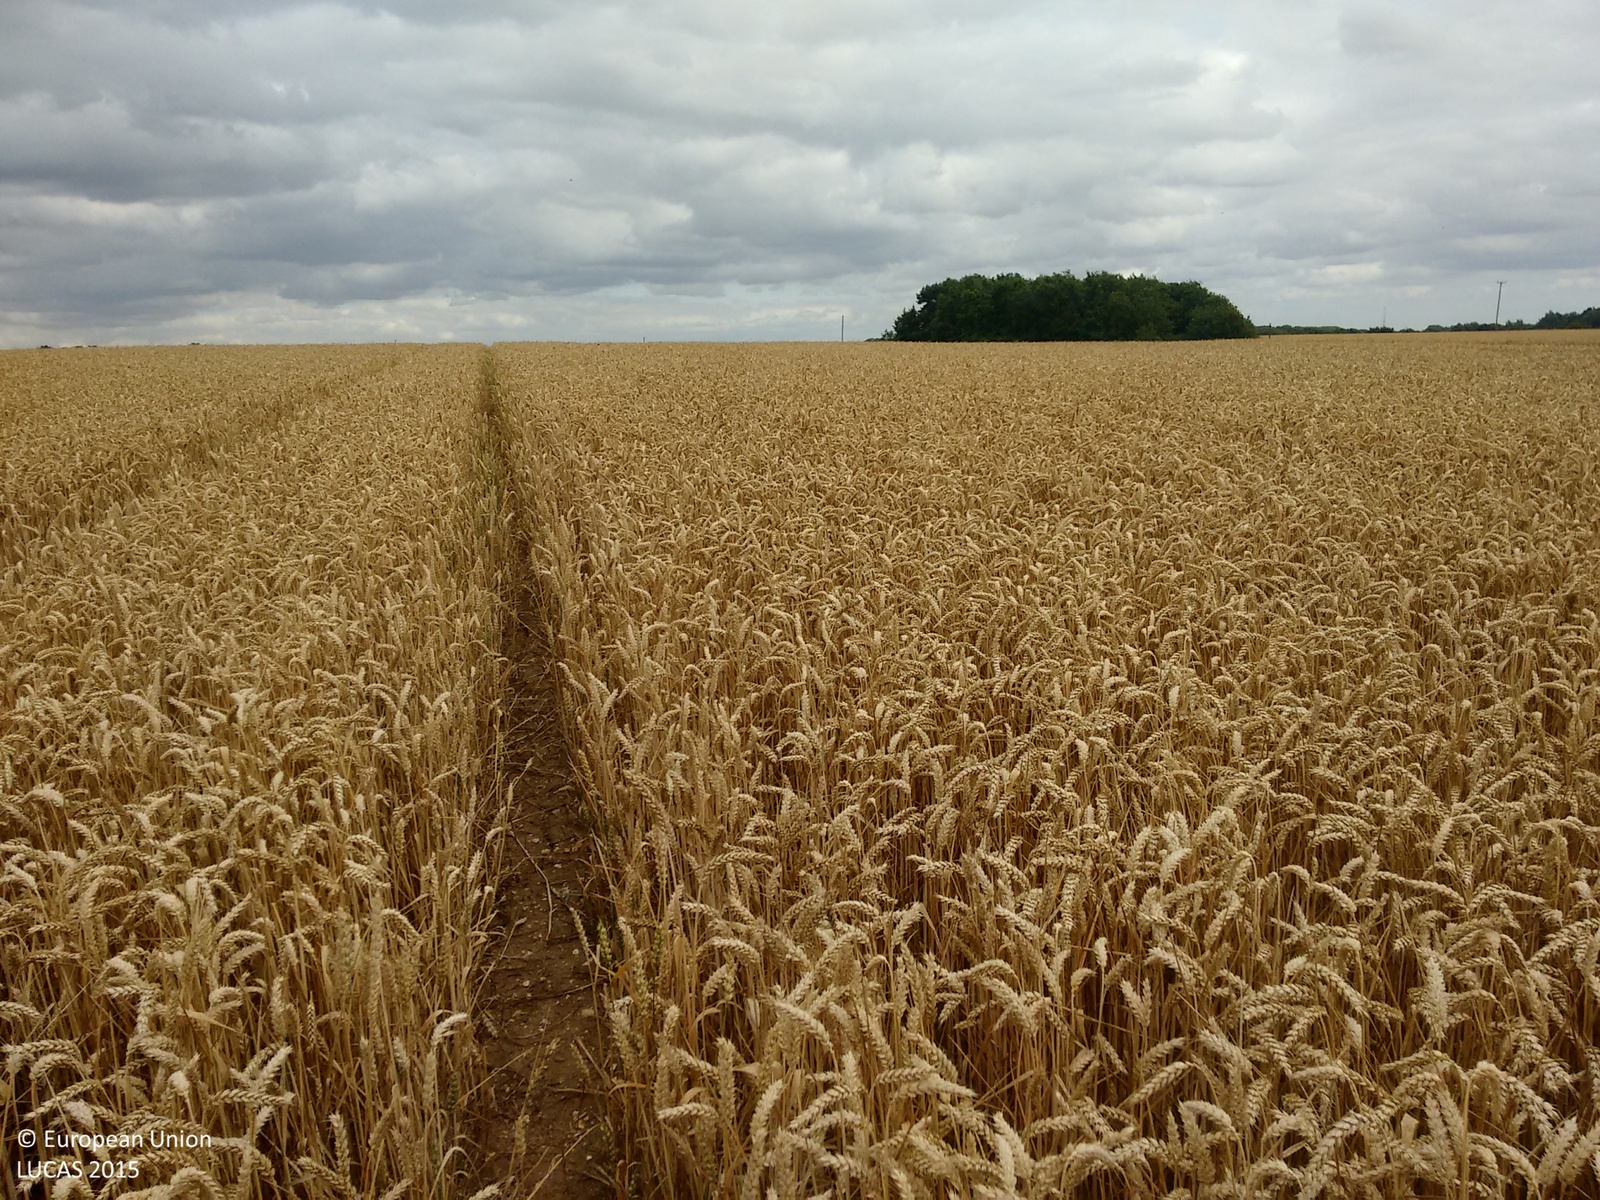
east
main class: Cropland
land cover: Common wheat
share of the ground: > 75 %
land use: Agriculture (excluding fallow land and kitchen gardens)
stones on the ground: 10 - 25 %
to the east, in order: Common wheat; Grassland without tree/shrub cover; Shrubland with sparse tree cover; Ditches and canals; Grass margins; Electric lines; Tracks; Grass margins; Managed hedges; Broadleaved woodland; Groves; Grass margins; Tracks; Grass margins; Electric lines; Common wheat
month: August
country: GB
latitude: 51.9261
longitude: 0.5349
